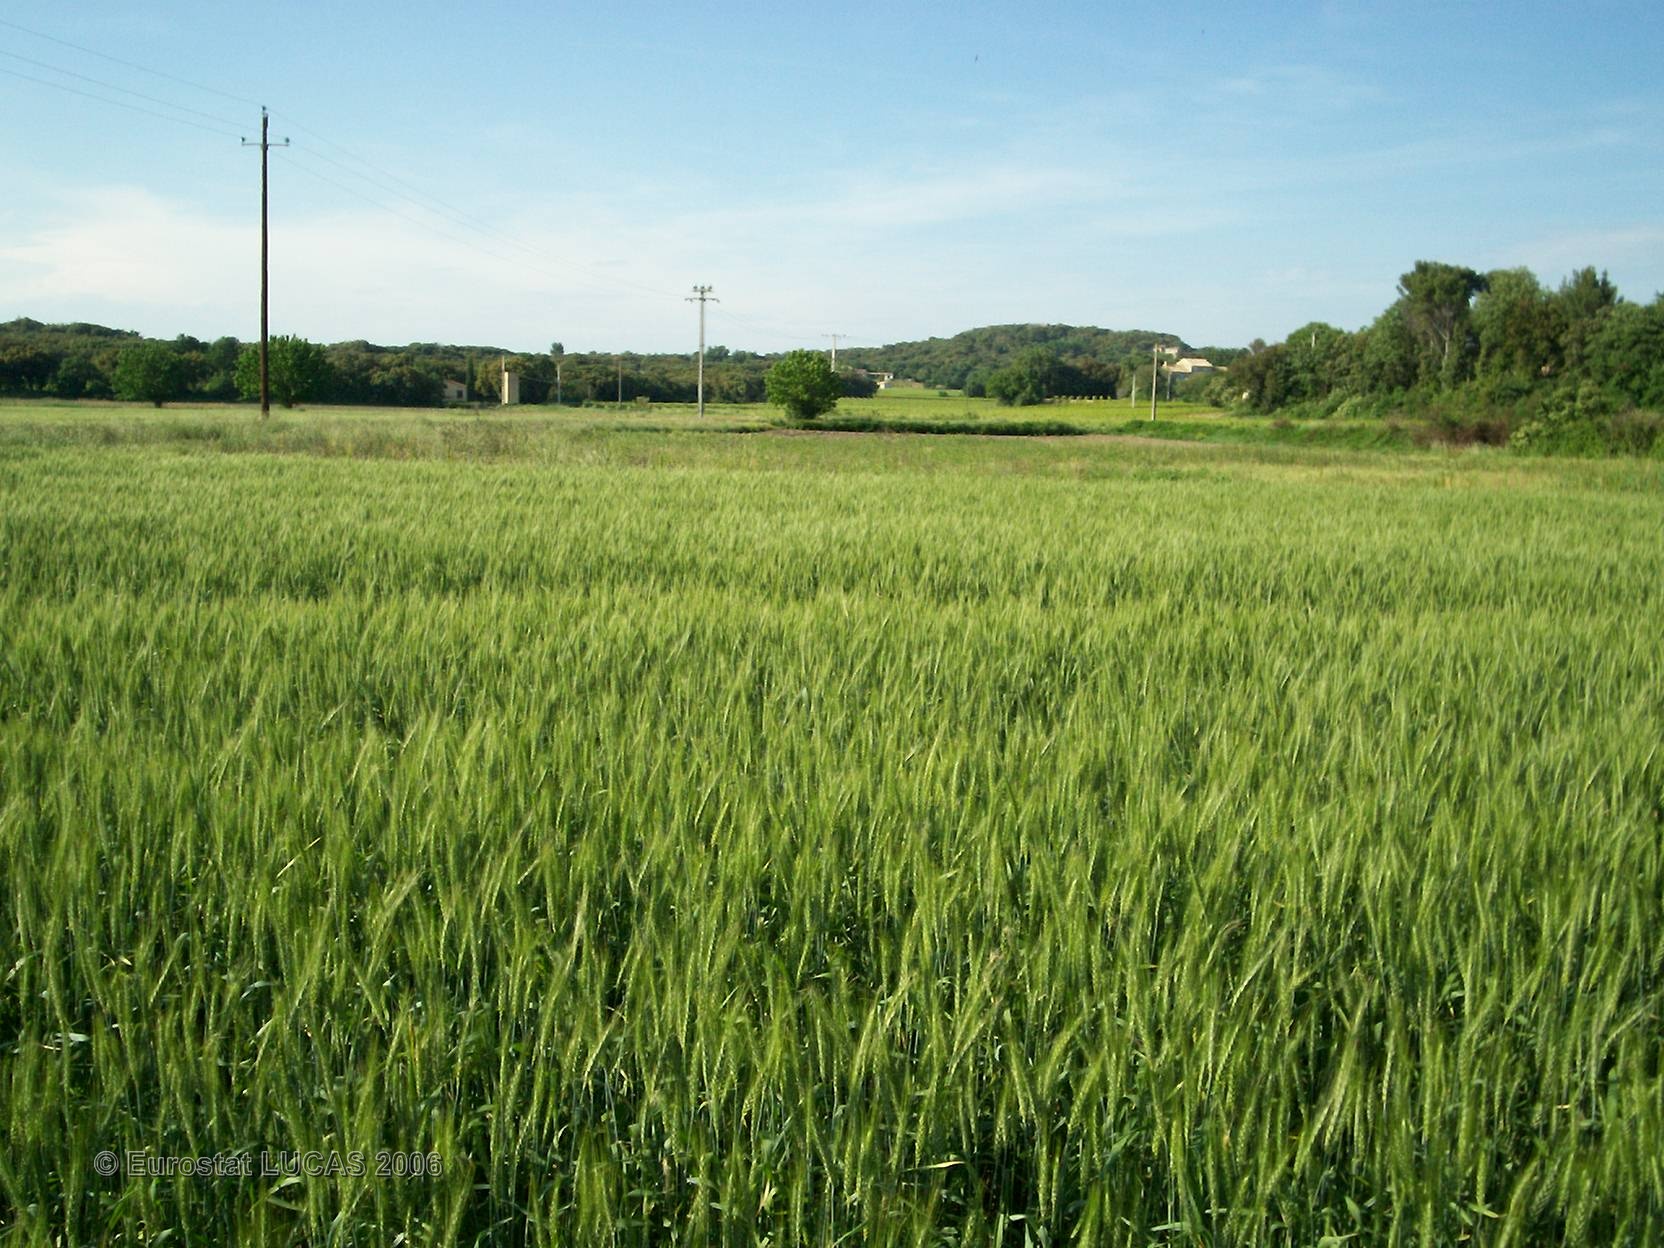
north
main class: Cropland
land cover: Barley
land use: Agriculture (excluding fallow land and kitchen gardens)
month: May
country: FR
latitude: 44.3313
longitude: 4.8531
